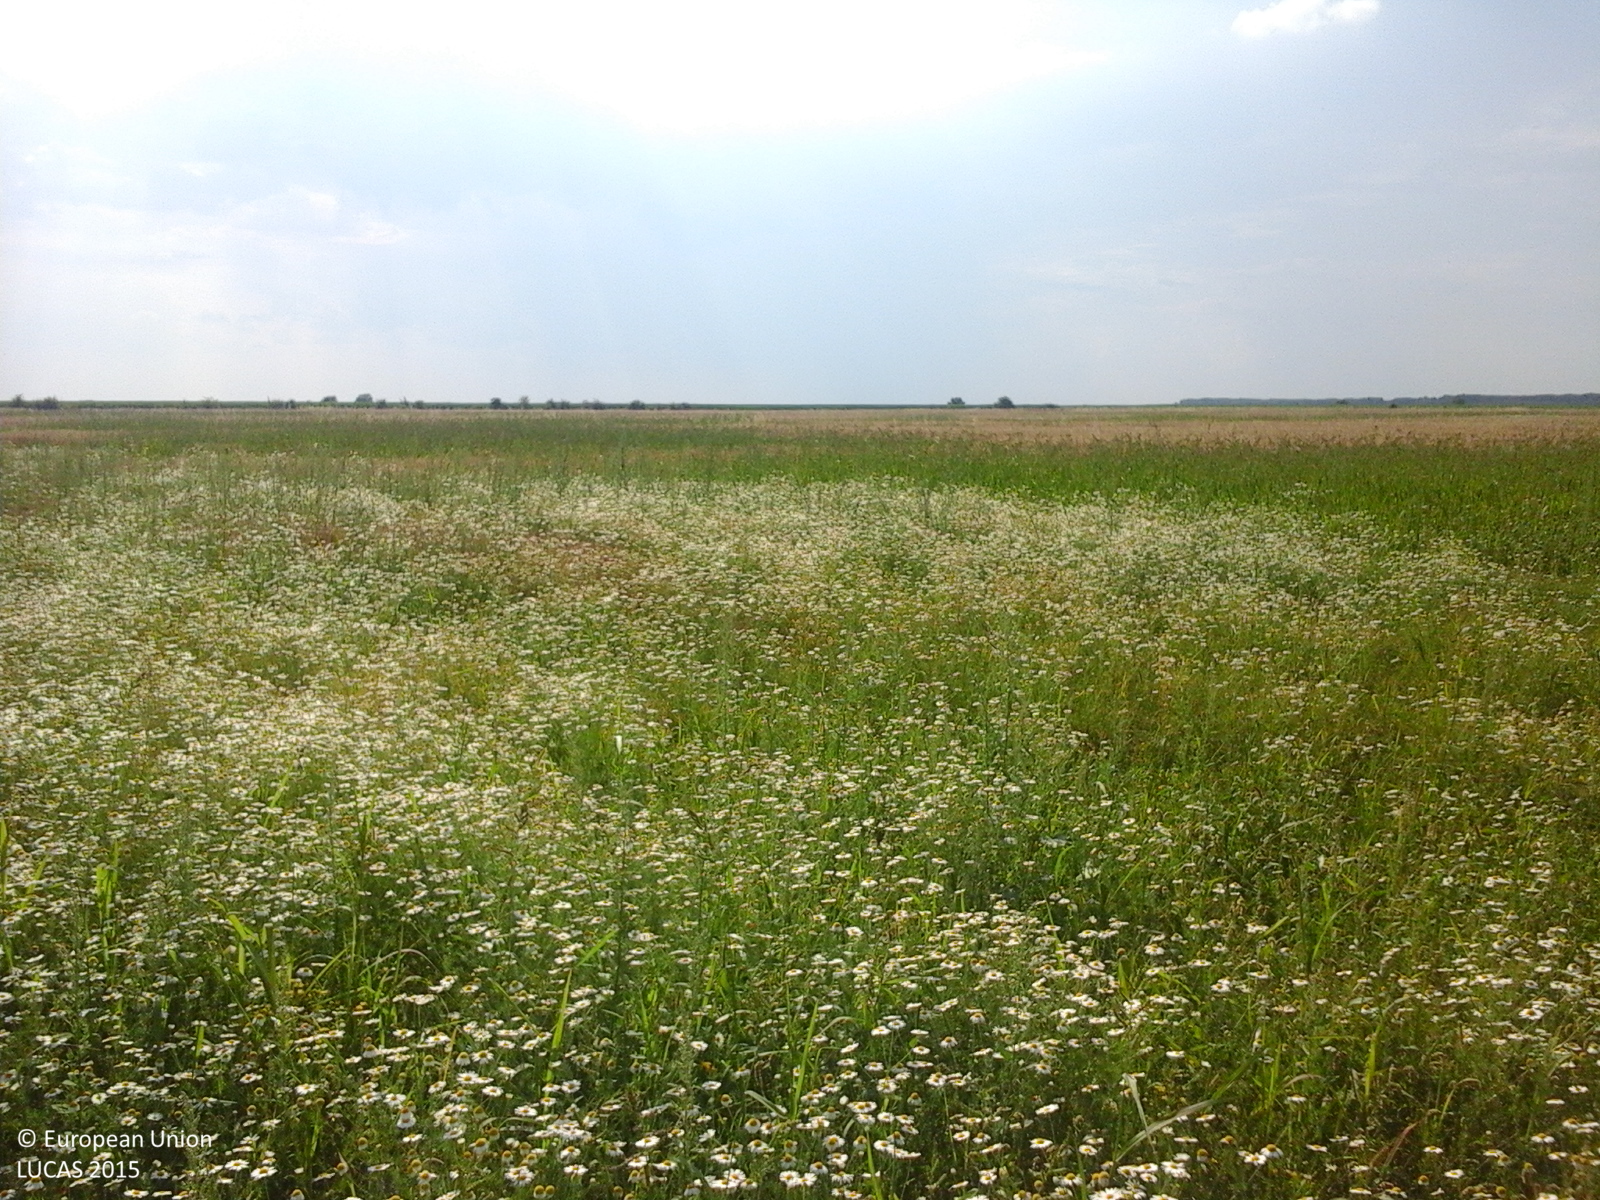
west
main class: Grassland
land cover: Grassland without tree/shrub cover
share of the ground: > 75 %
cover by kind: herbaceous plants 100 %
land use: Agriculture (excluding fallow land and kitchen gardens)
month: July
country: RO
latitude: 44.0649
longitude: 25.8124
